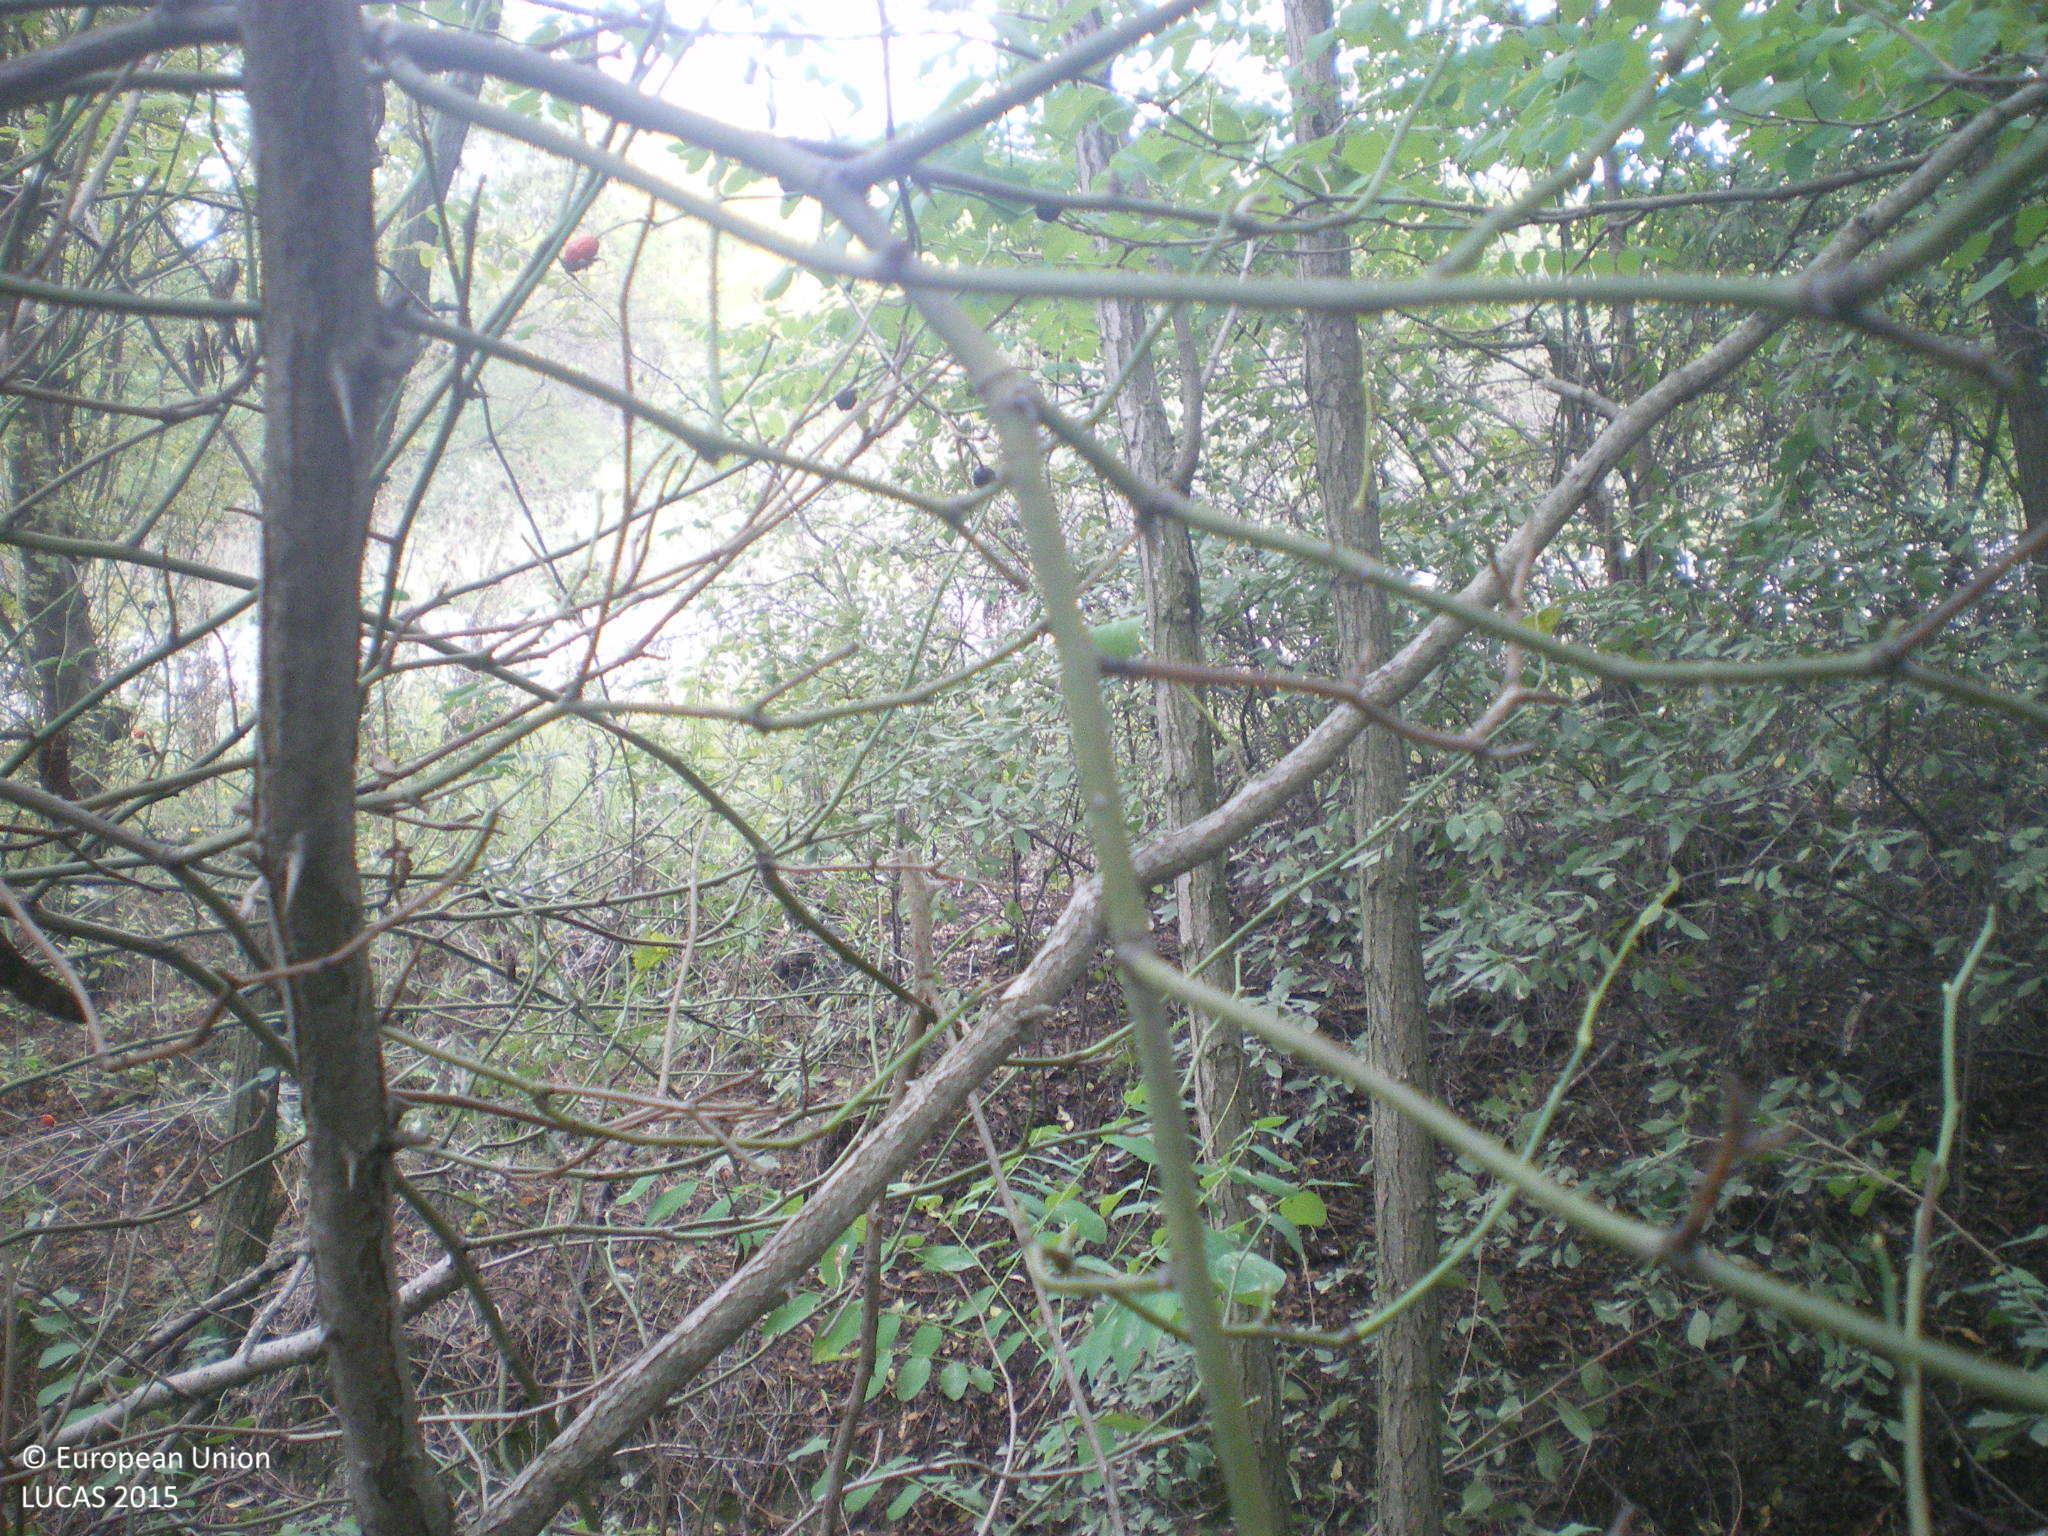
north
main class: Woodland
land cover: Broadleaved woodland
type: mesophytic deciduous forest
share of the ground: > 75 %
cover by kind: broadleaved forest trees 95 %, unconsolidated bare surface 5 %
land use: Forestry
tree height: > 5 m
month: October
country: BG
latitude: 42.1713
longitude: 25.9456
